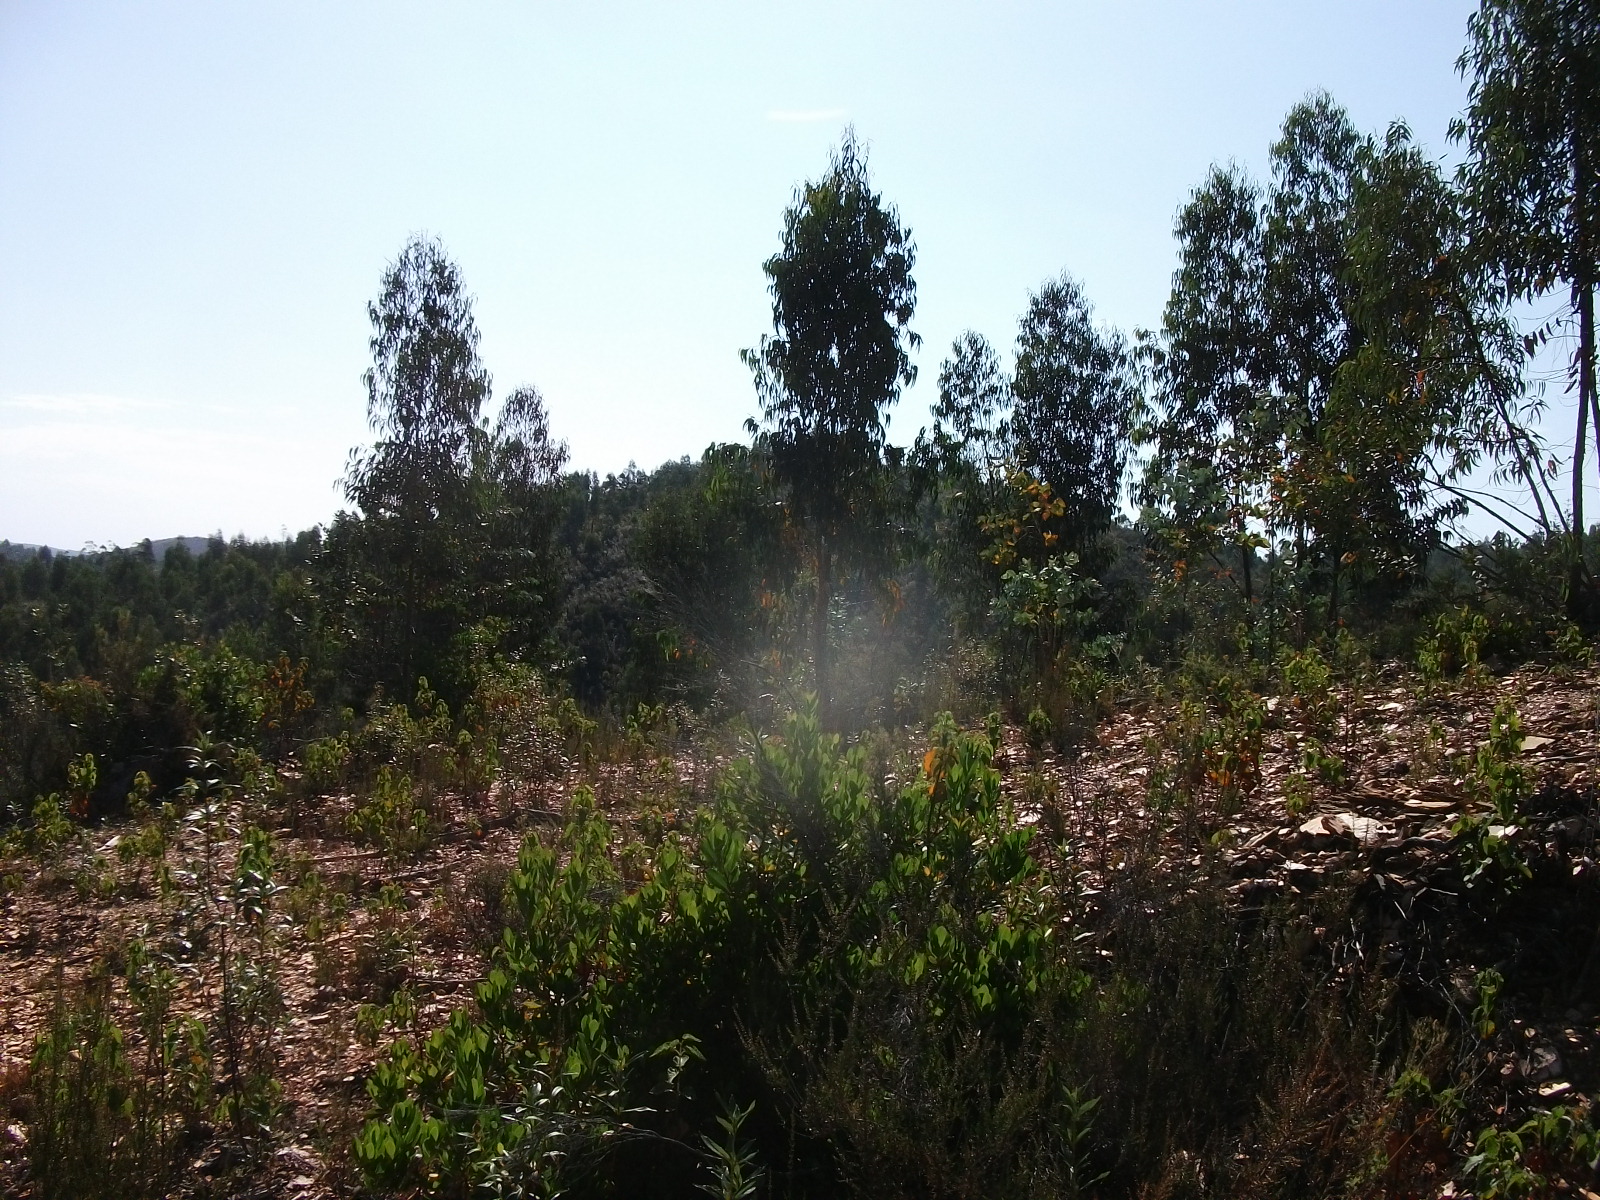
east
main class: Woodland
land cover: Broadleaved woodland
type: exotic forest
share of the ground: 50 - 75 %
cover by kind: broadleaved forest trees 60 %, shrubs 30 %, unconsolidated bare surface 10 %
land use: Forestry
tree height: > 5 m
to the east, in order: Broadleaved woodland; Tracks; Broadleaved woodland; Tracks; Broadleaved woodland
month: May
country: ES
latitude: 37.5968
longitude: -6.6549
